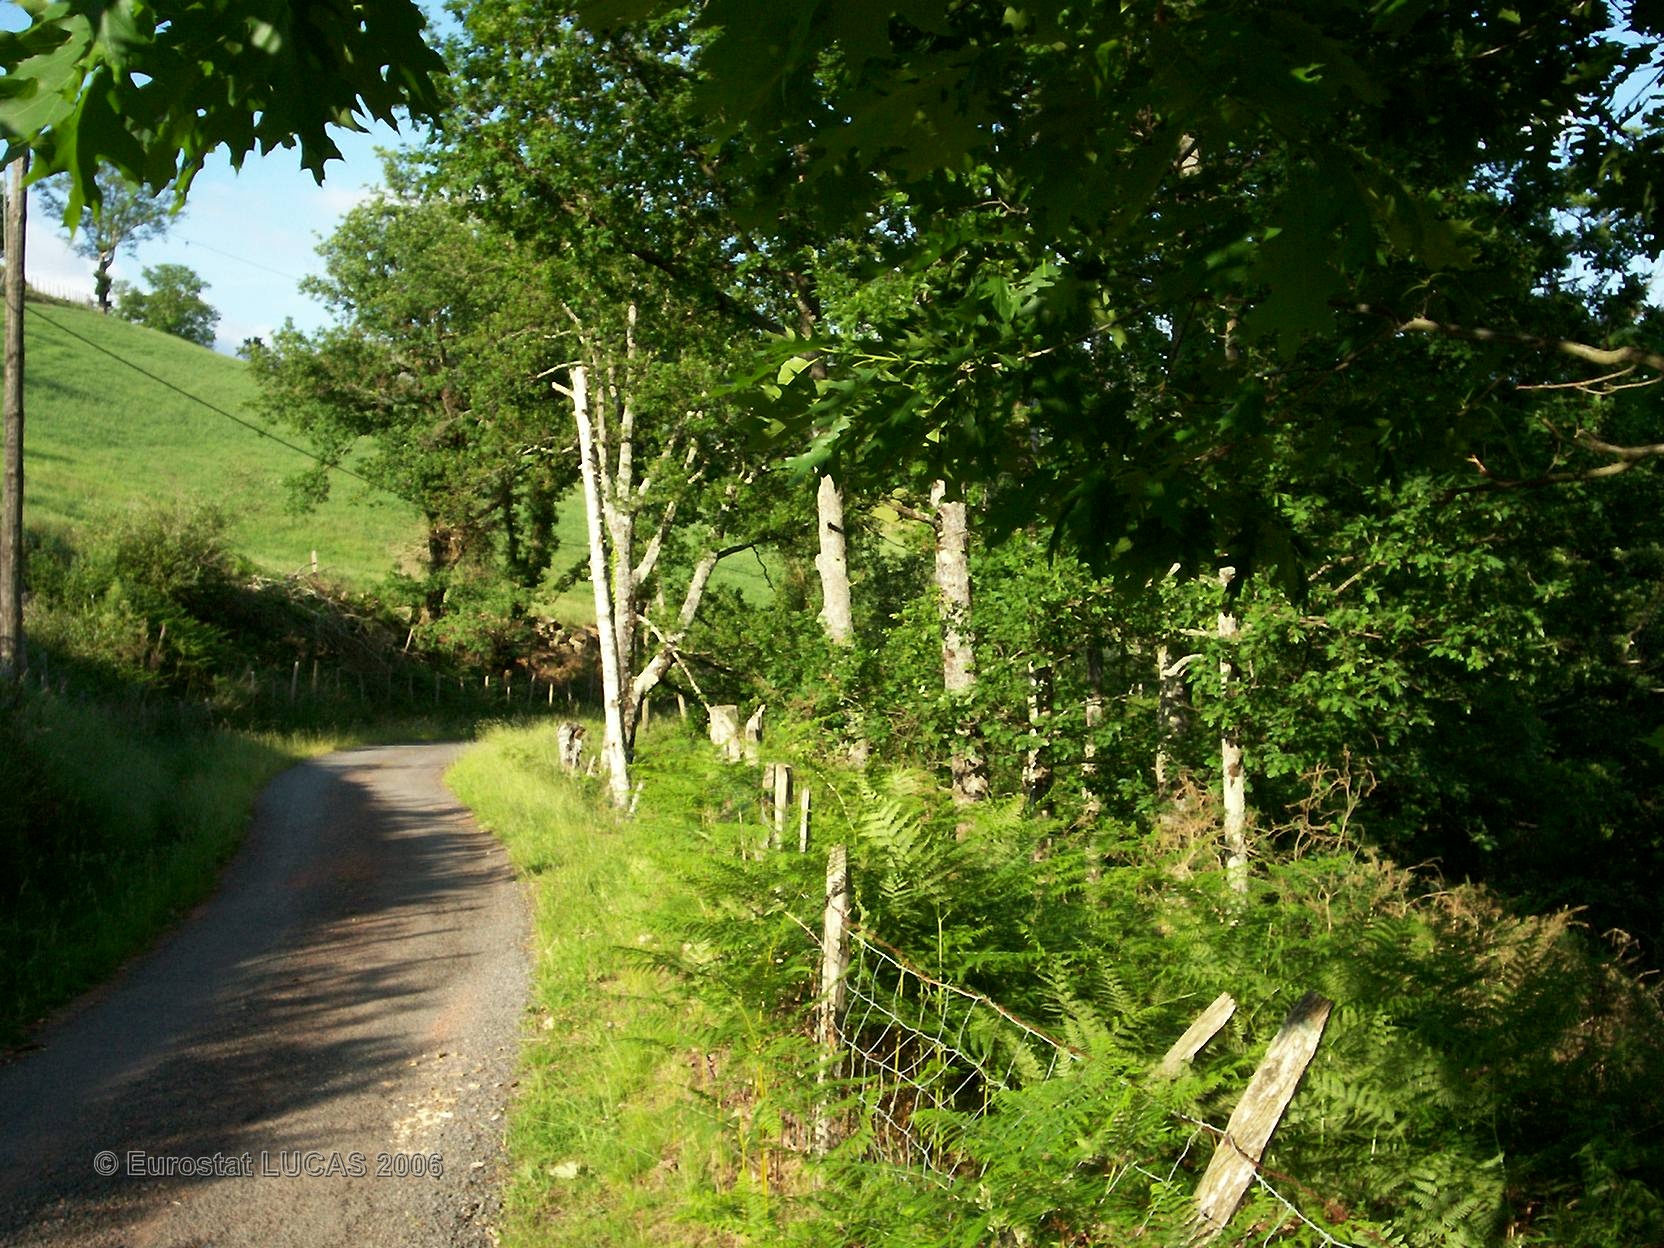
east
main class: Woodland
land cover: Broadleaved forest
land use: Forestry
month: May
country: FR
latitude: 43.2541
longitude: -1.3349
